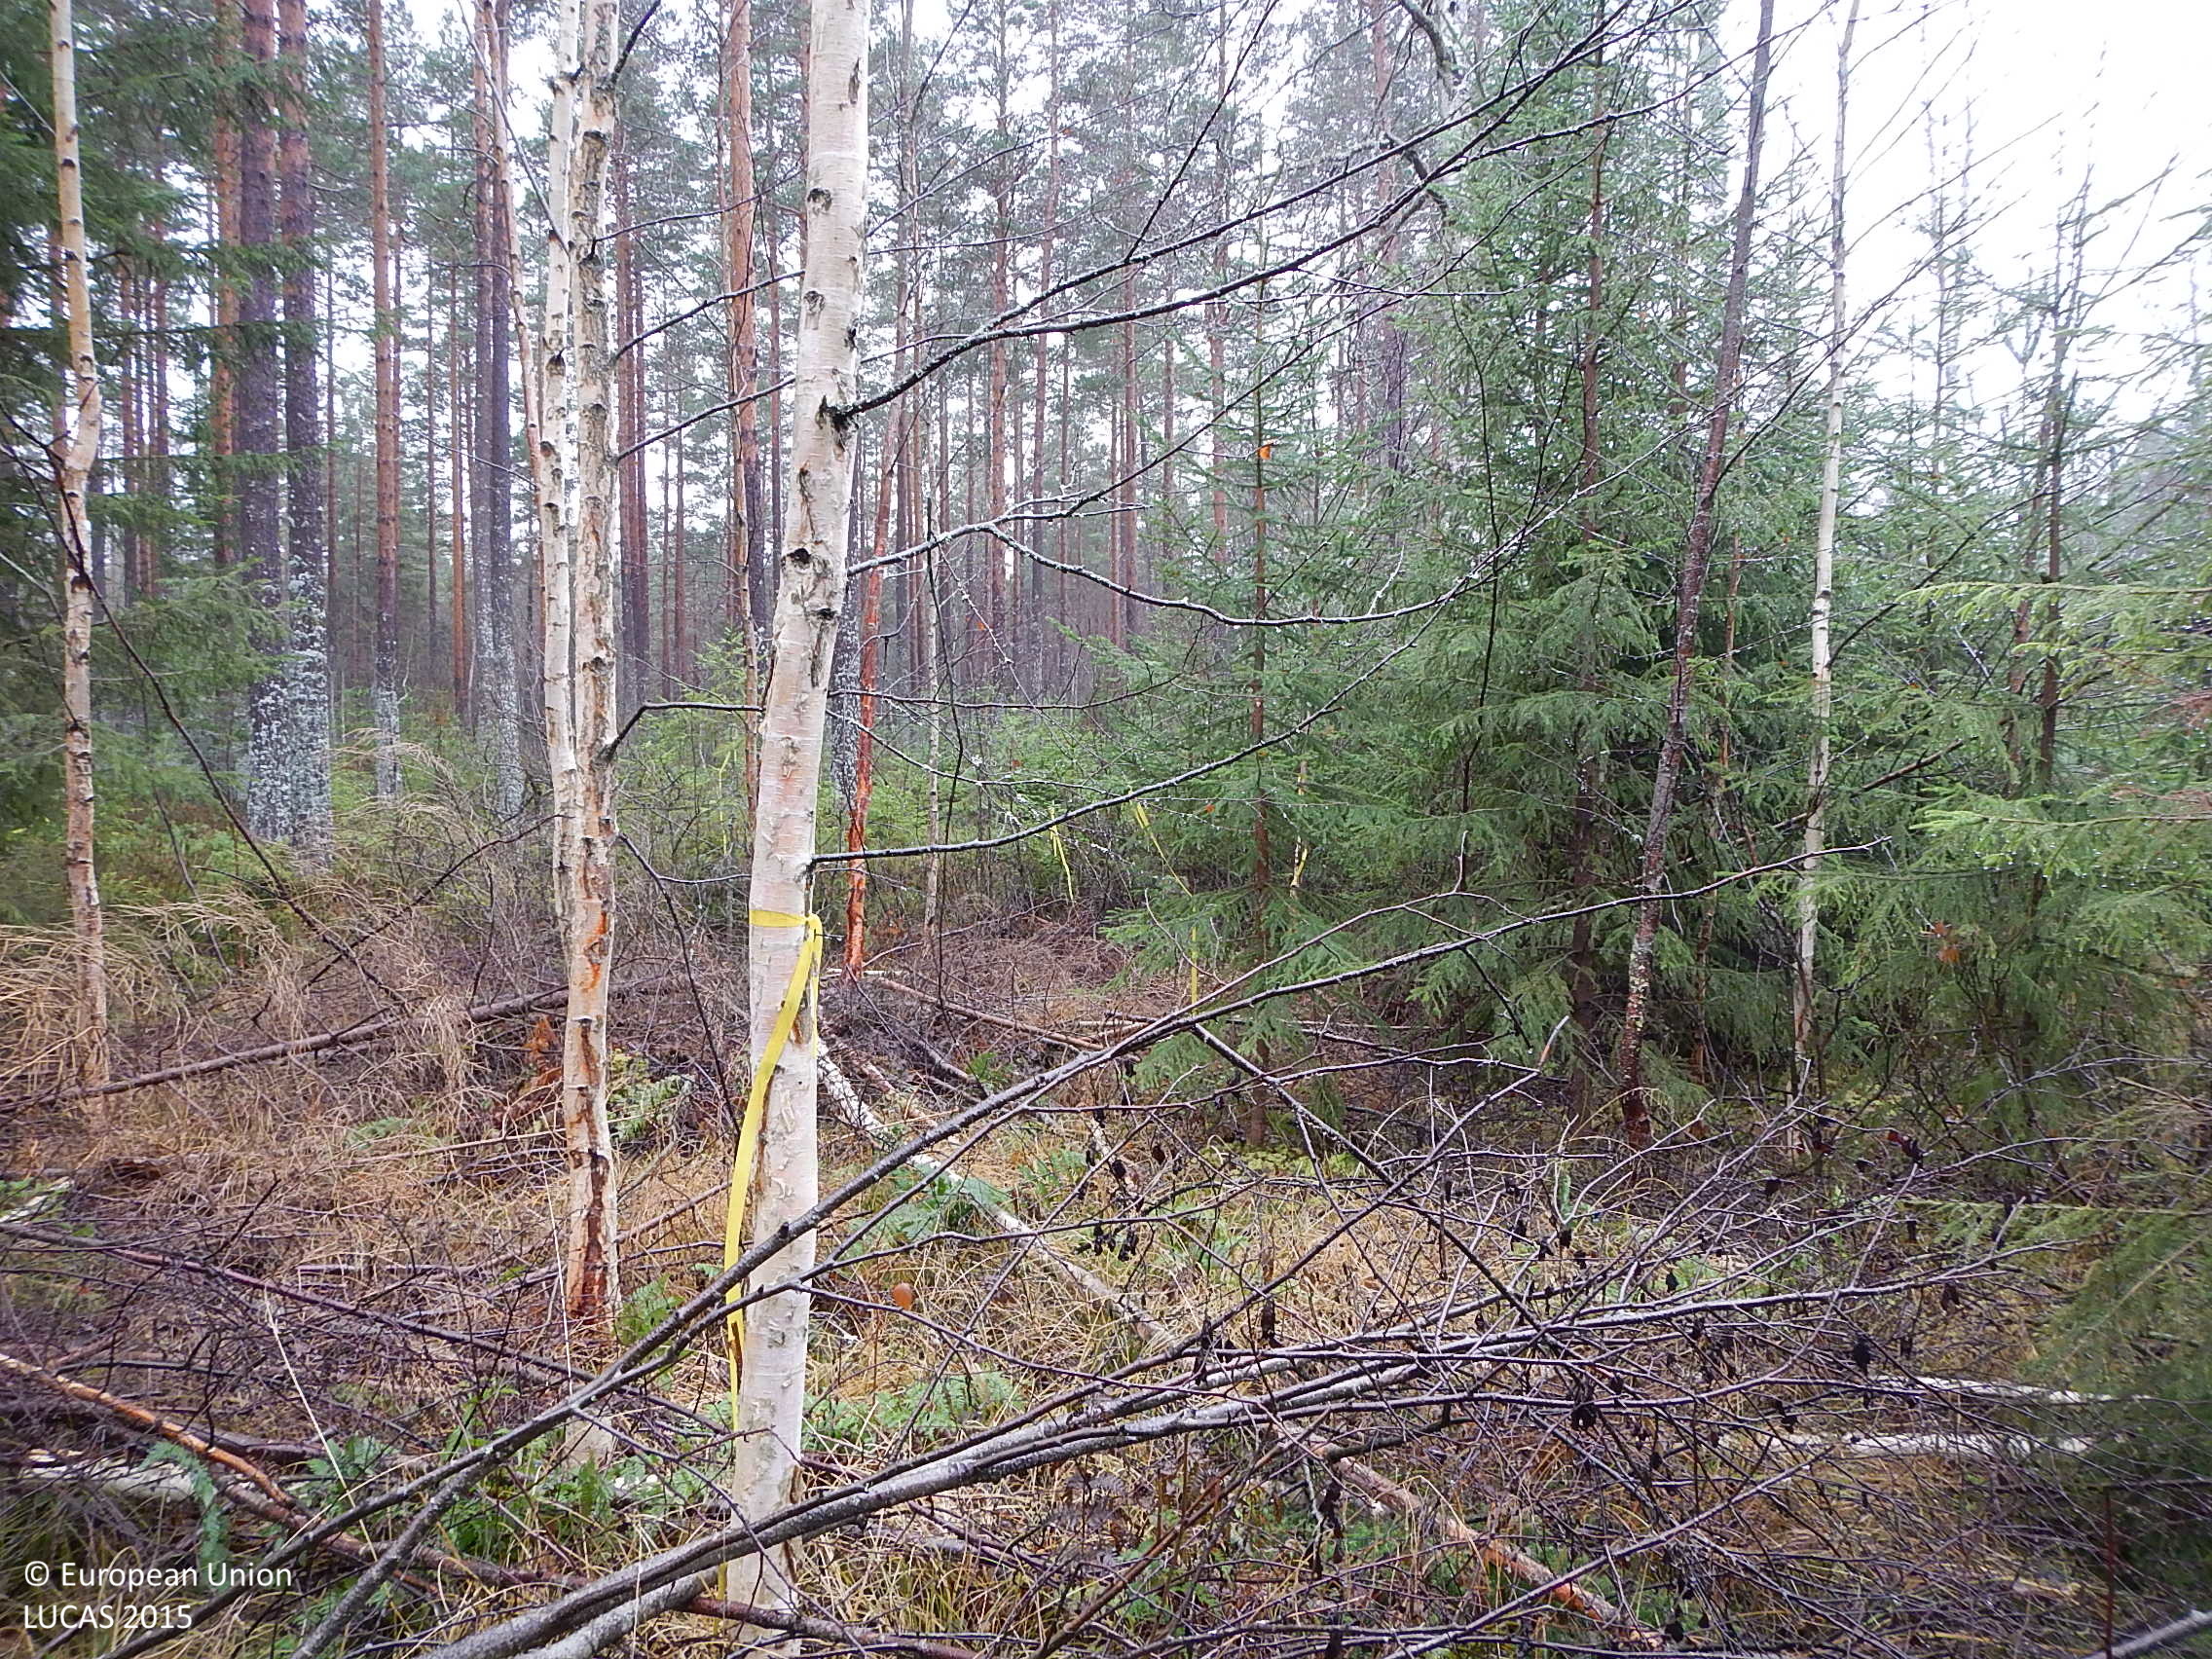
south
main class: Woodland
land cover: Spruce dominated mixed woodland
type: boreal forest
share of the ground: > 75 %
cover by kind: broadleaved forest trees 50 %, coniferous forest trees 35 %, herbaceous plants 5 %
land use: Forestry
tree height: > 5 m
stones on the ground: < 10 %
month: November
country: SE
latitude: 61.3473
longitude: 16.9588
